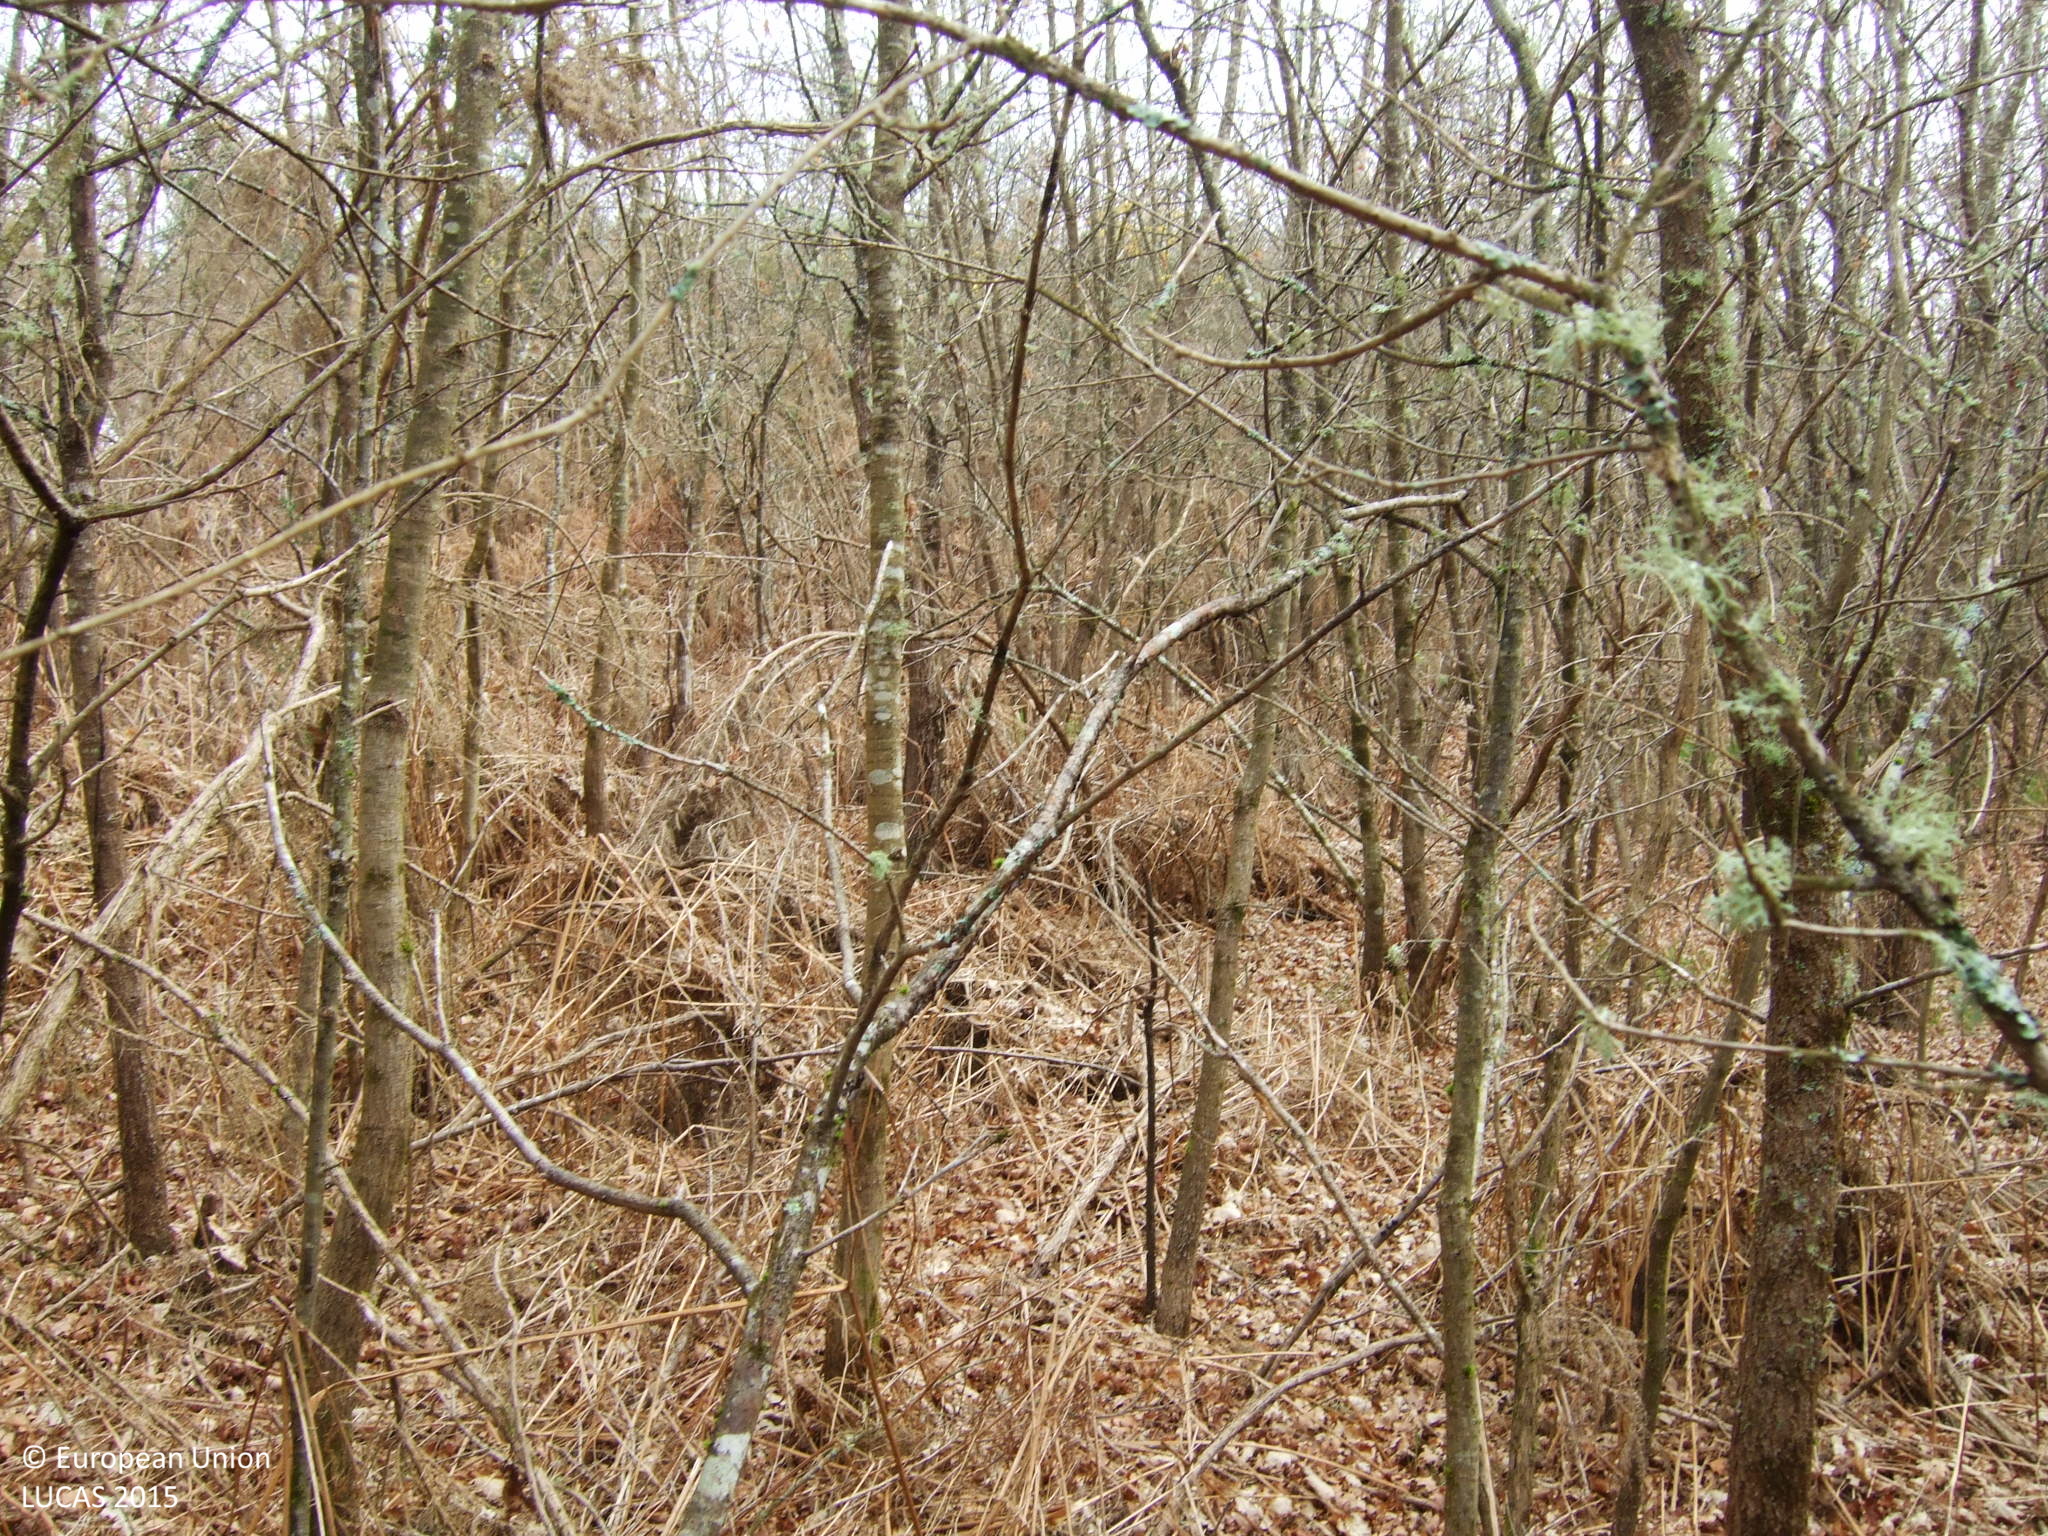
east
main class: Woodland
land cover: Broadleaved woodland
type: acidophilous oak and oak-birch forest
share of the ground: 50 - 75 %
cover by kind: broadleaved forest trees 70 %, shrubs 30 %
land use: Semi-natural and natural areas not in use
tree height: > 5 m
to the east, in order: Broadleaved woodland; Fences; Pine dominated coniferous woodland; Broadleaved woodland; Fences; Grassland without tree/shrub cover; Dry stone walls; Broadleaved woodland
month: April
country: ES
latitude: 42.7750
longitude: -7.8160
